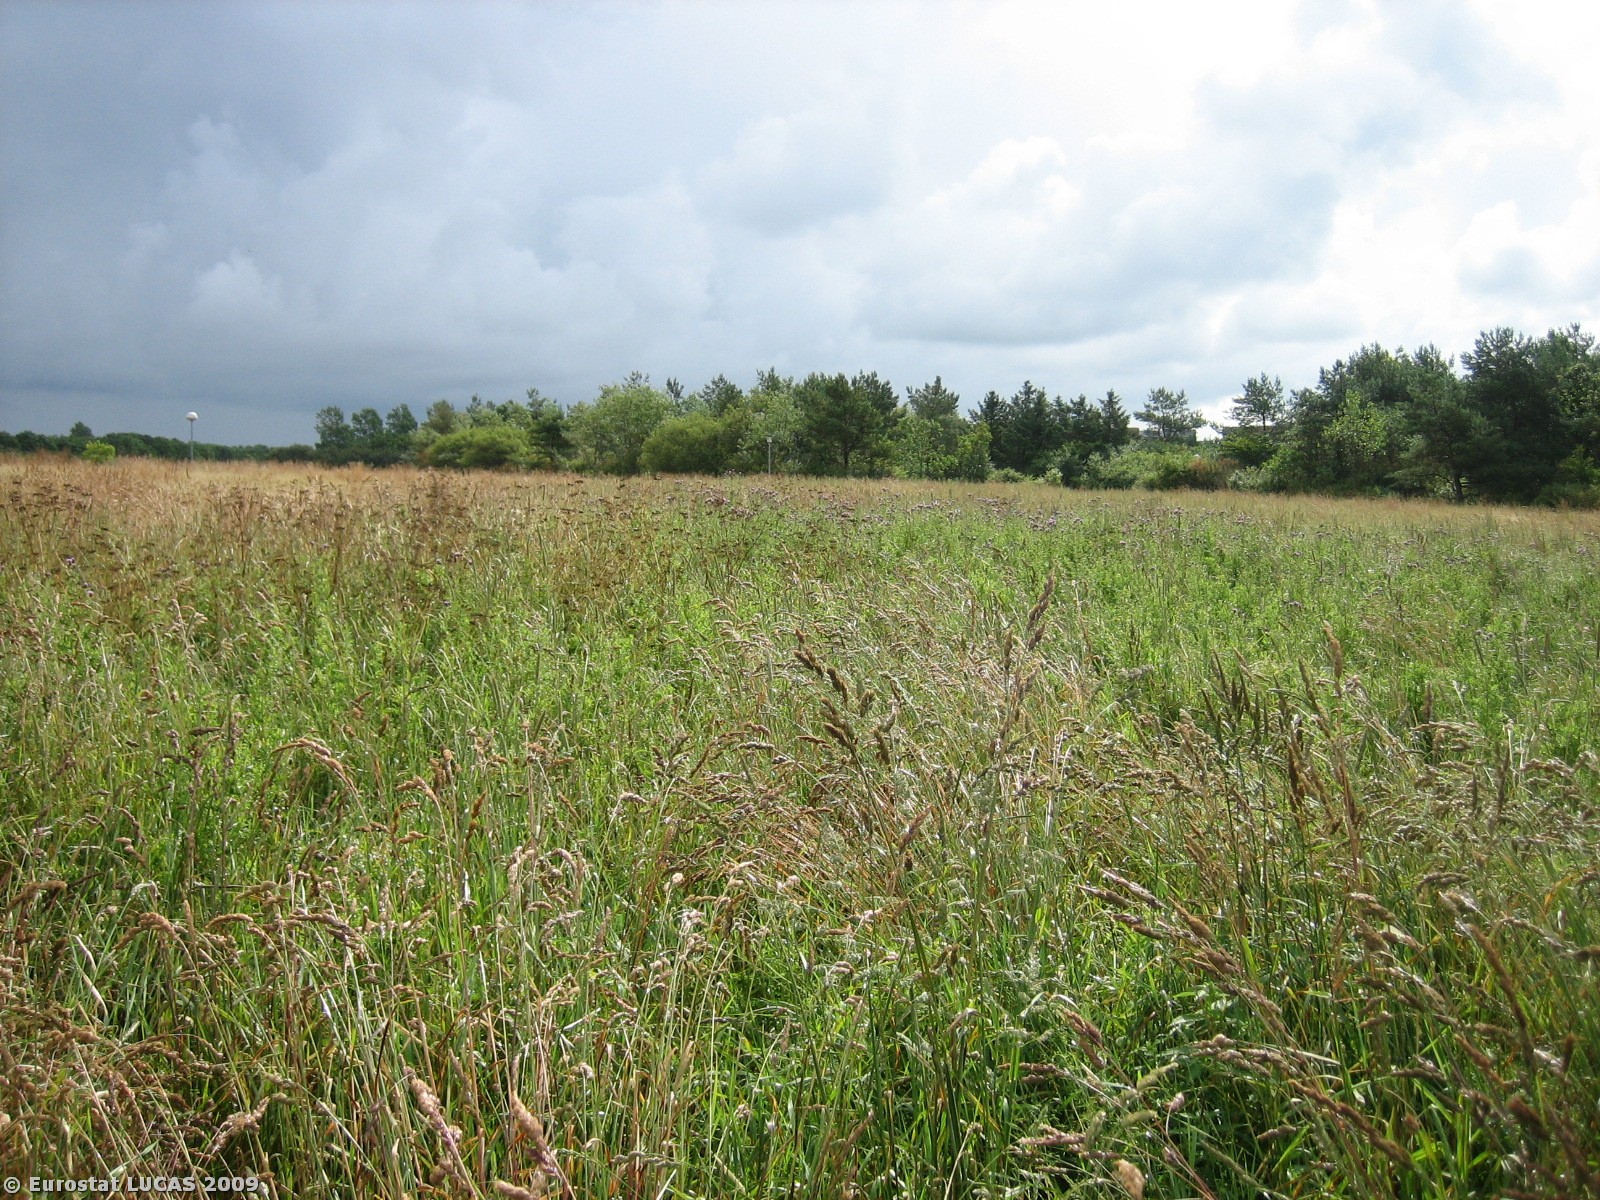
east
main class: Grassland
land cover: Grassland without tree/shrub cover
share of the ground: > 75 %
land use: Amenities, museums, leisure
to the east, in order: Grassland without tree/shrub cover; Tracks; Coniferous woodland; Tracks; Broadleaved woodland; Artificial constructions in urban areas; Managed hedges; Grassland without tree/shrub cover; Managed hedges; Artificial constructions in urban areas; Managed hedges; Grassland without tree/shrub cover; Artificial constructions in urban areas
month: July
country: DK
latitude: 55.5130
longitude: 8.4336
